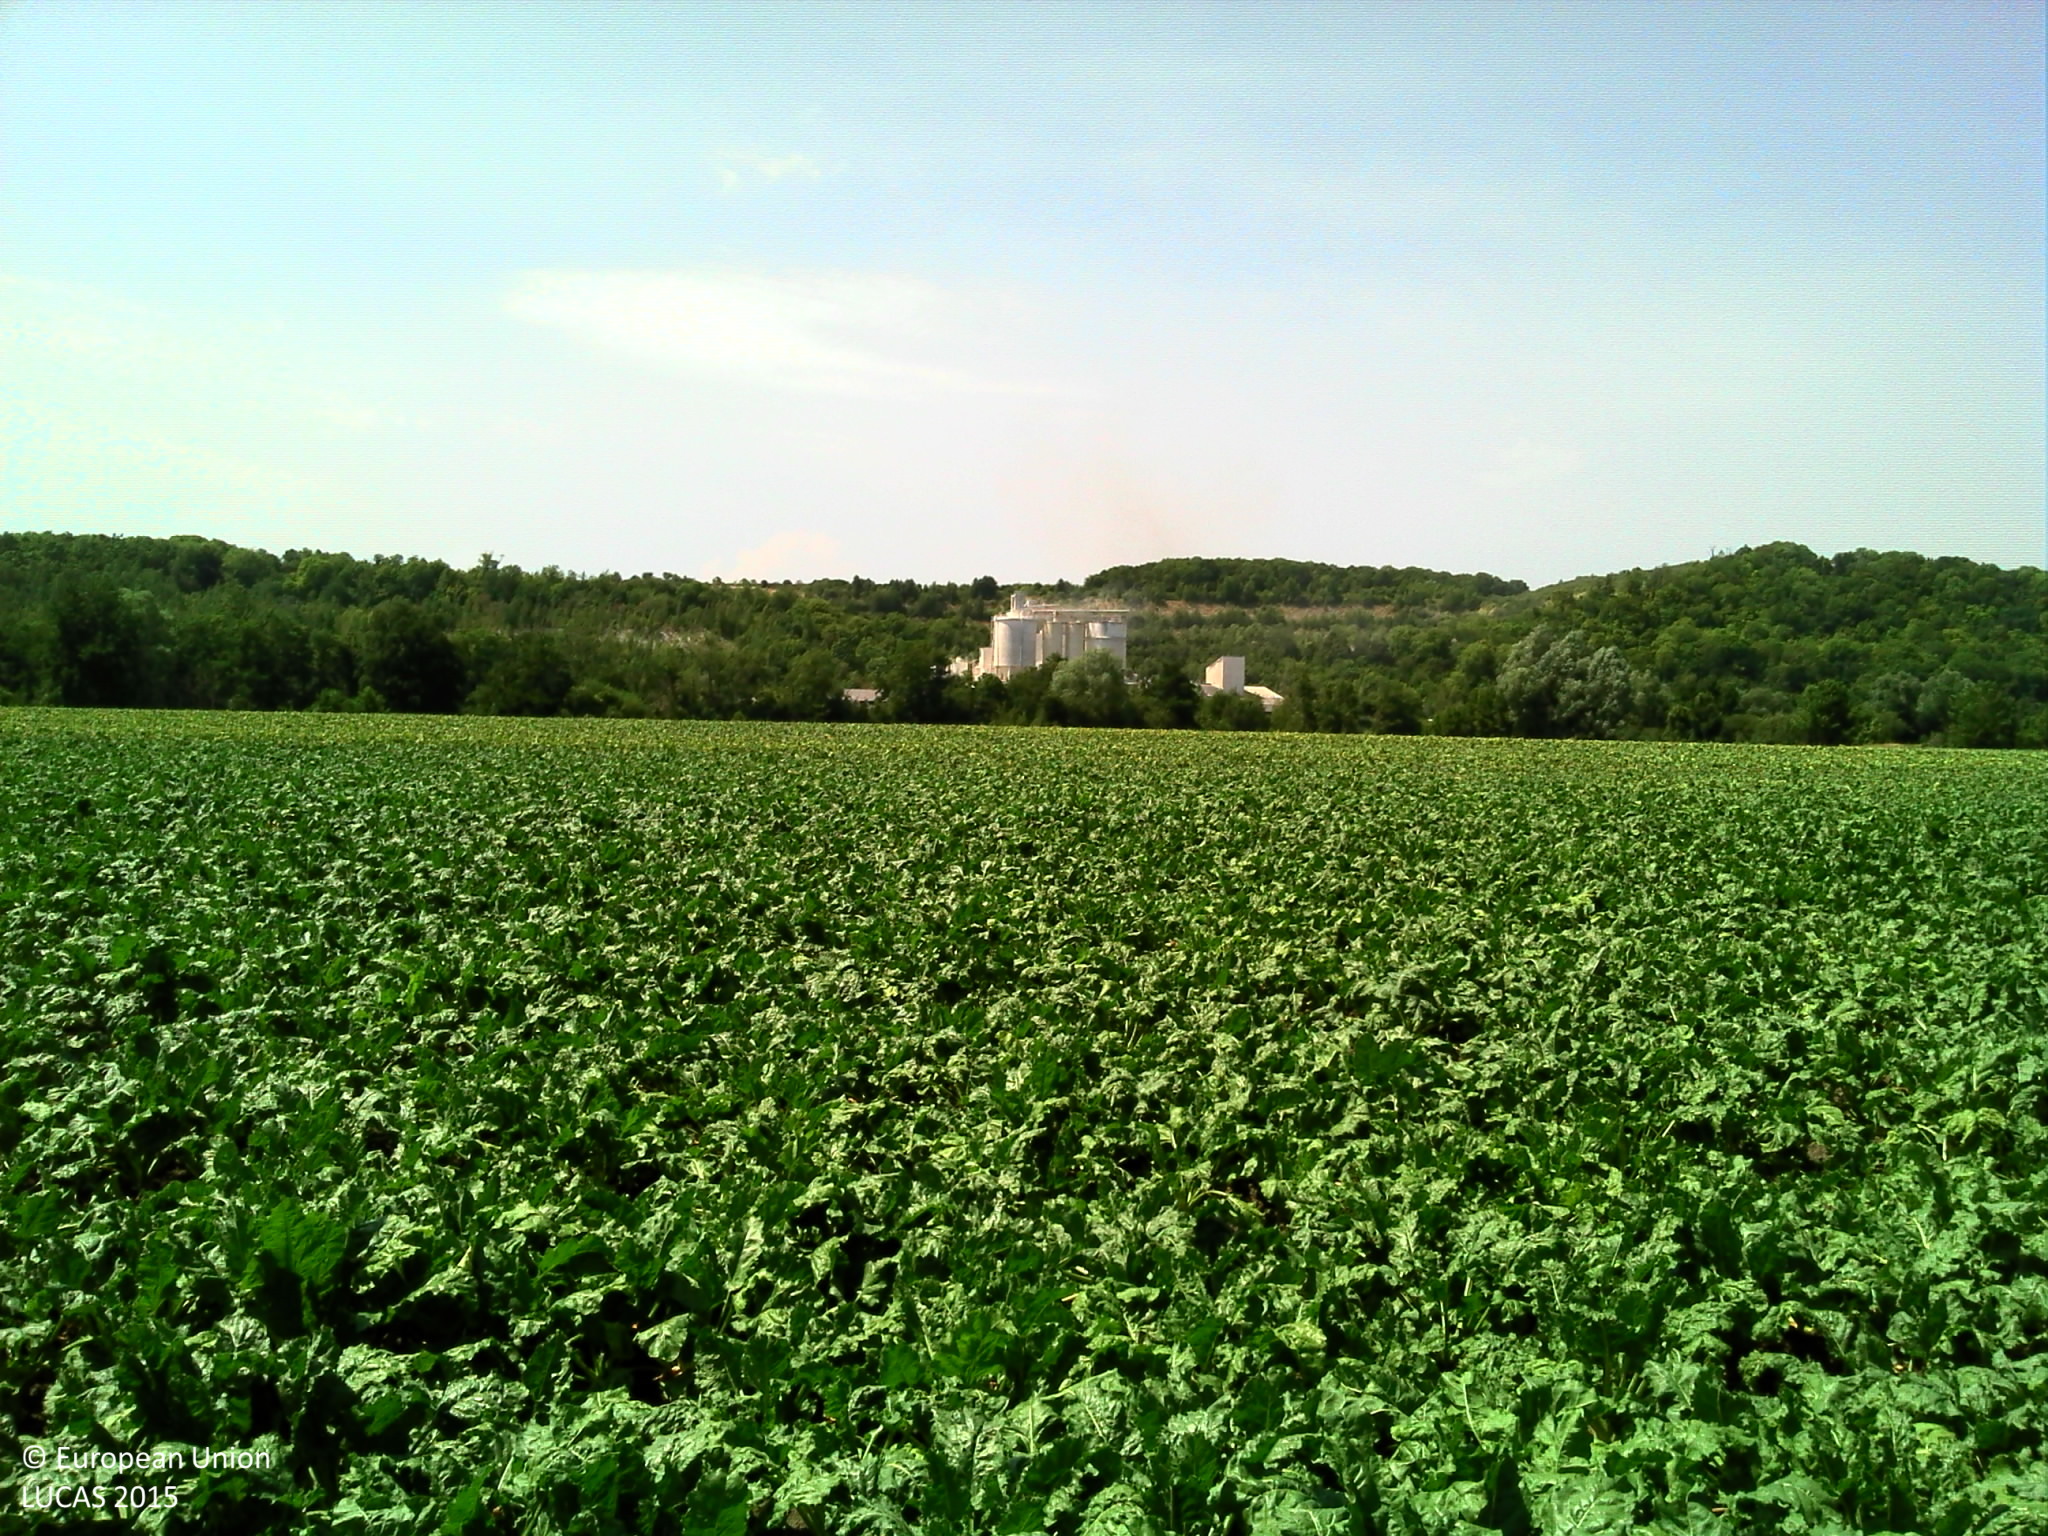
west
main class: Cropland
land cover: Sugar beet
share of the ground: > 75 %
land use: Agriculture (excluding fallow land and kitchen gardens)
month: July
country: FR
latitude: 49.1879
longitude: 2.3726
